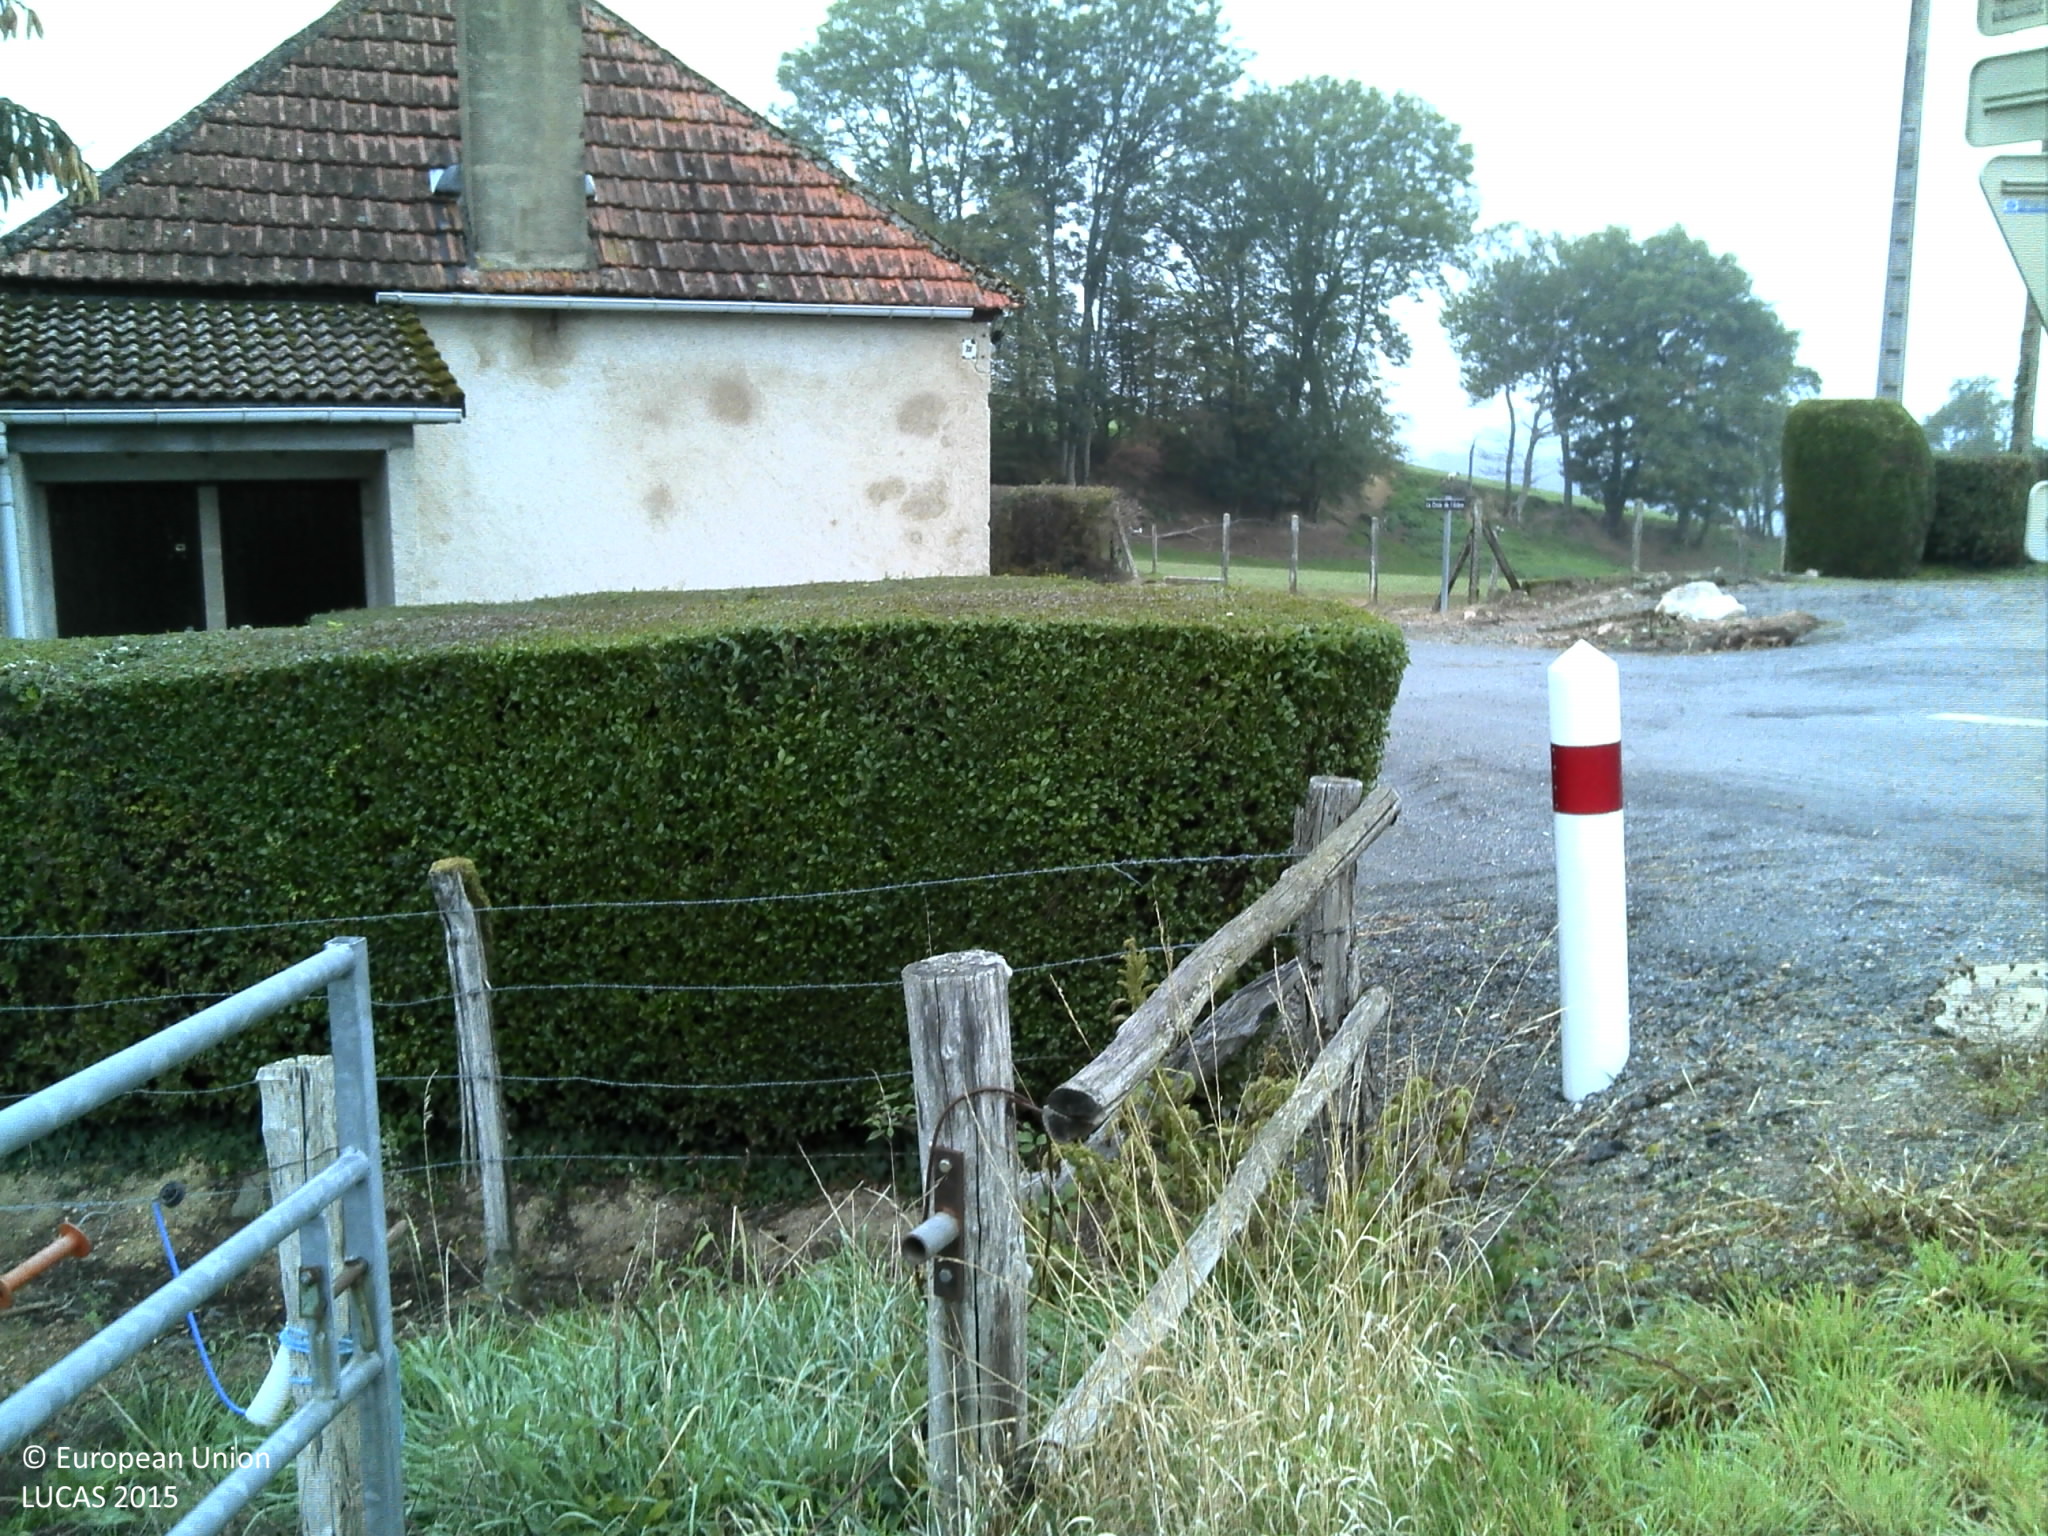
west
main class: Grassland
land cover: Grassland without tree/shrub cover
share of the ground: > 75 %
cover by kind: herbaceous plants 100 %
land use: Agriculture (excluding fallow land and kitchen gardens)
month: October
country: FR
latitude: 46.7450
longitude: 4.0442
